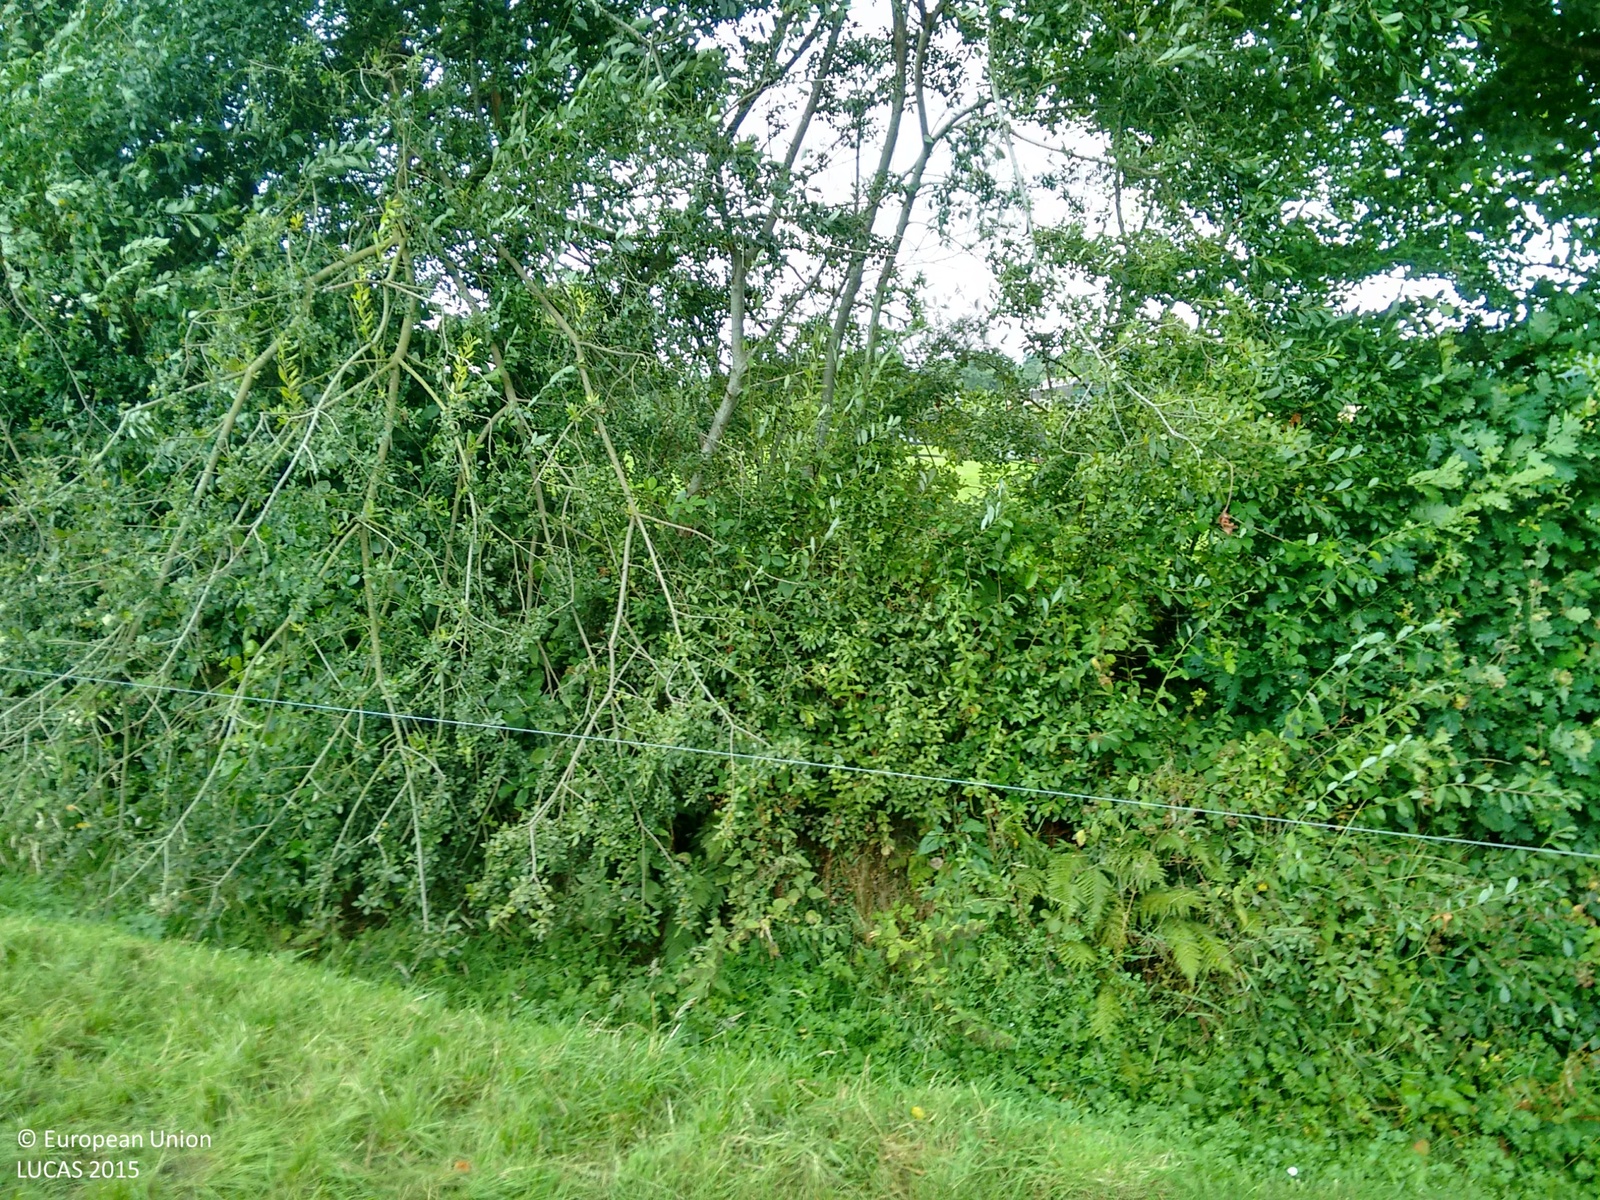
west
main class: Grassland
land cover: Grassland without tree/shrub cover
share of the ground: > 75 %
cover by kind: herbaceous plants 100 %
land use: Agriculture (excluding fallow land and kitchen gardens)
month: August
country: IE
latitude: 52.4472
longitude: -6.5946
